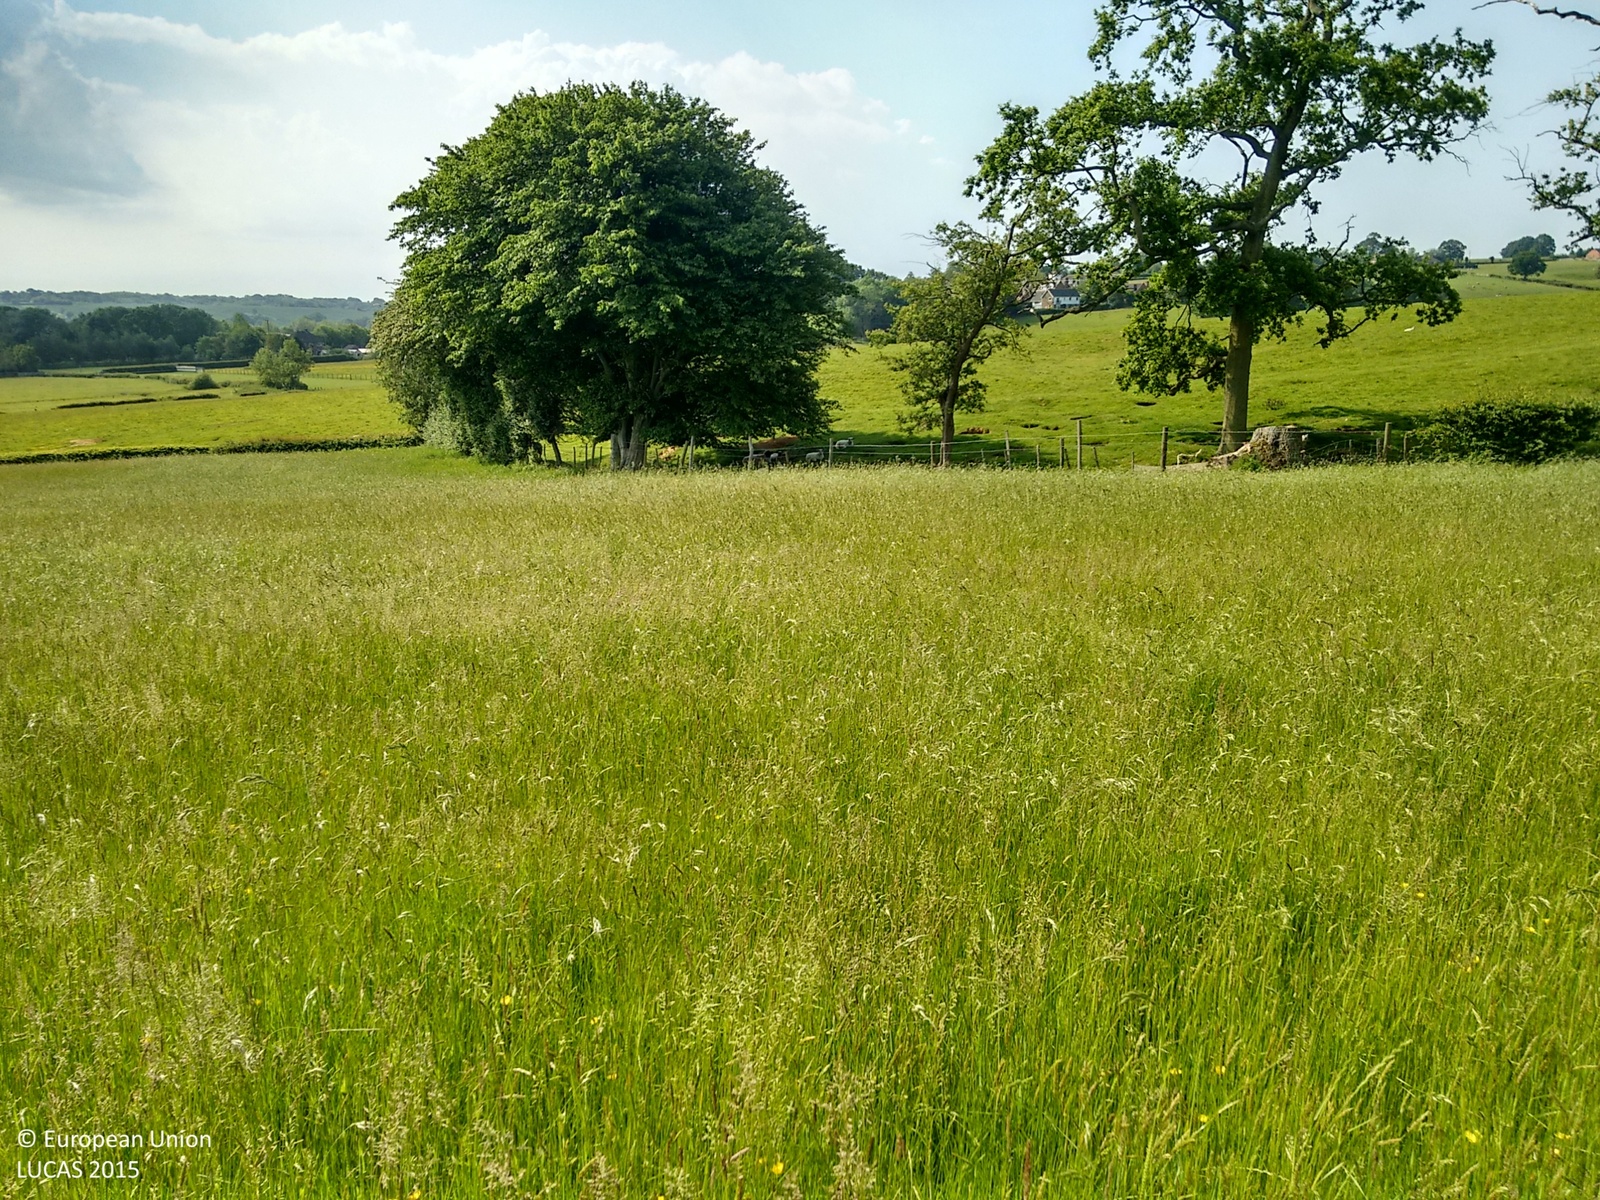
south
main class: Grassland
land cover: Grassland without tree/shrub cover
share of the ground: > 75 %
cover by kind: herbaceous plants 100 %
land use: Agriculture (excluding fallow land and kitchen gardens)
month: June
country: GB
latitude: 51.0669
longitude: 0.6551
